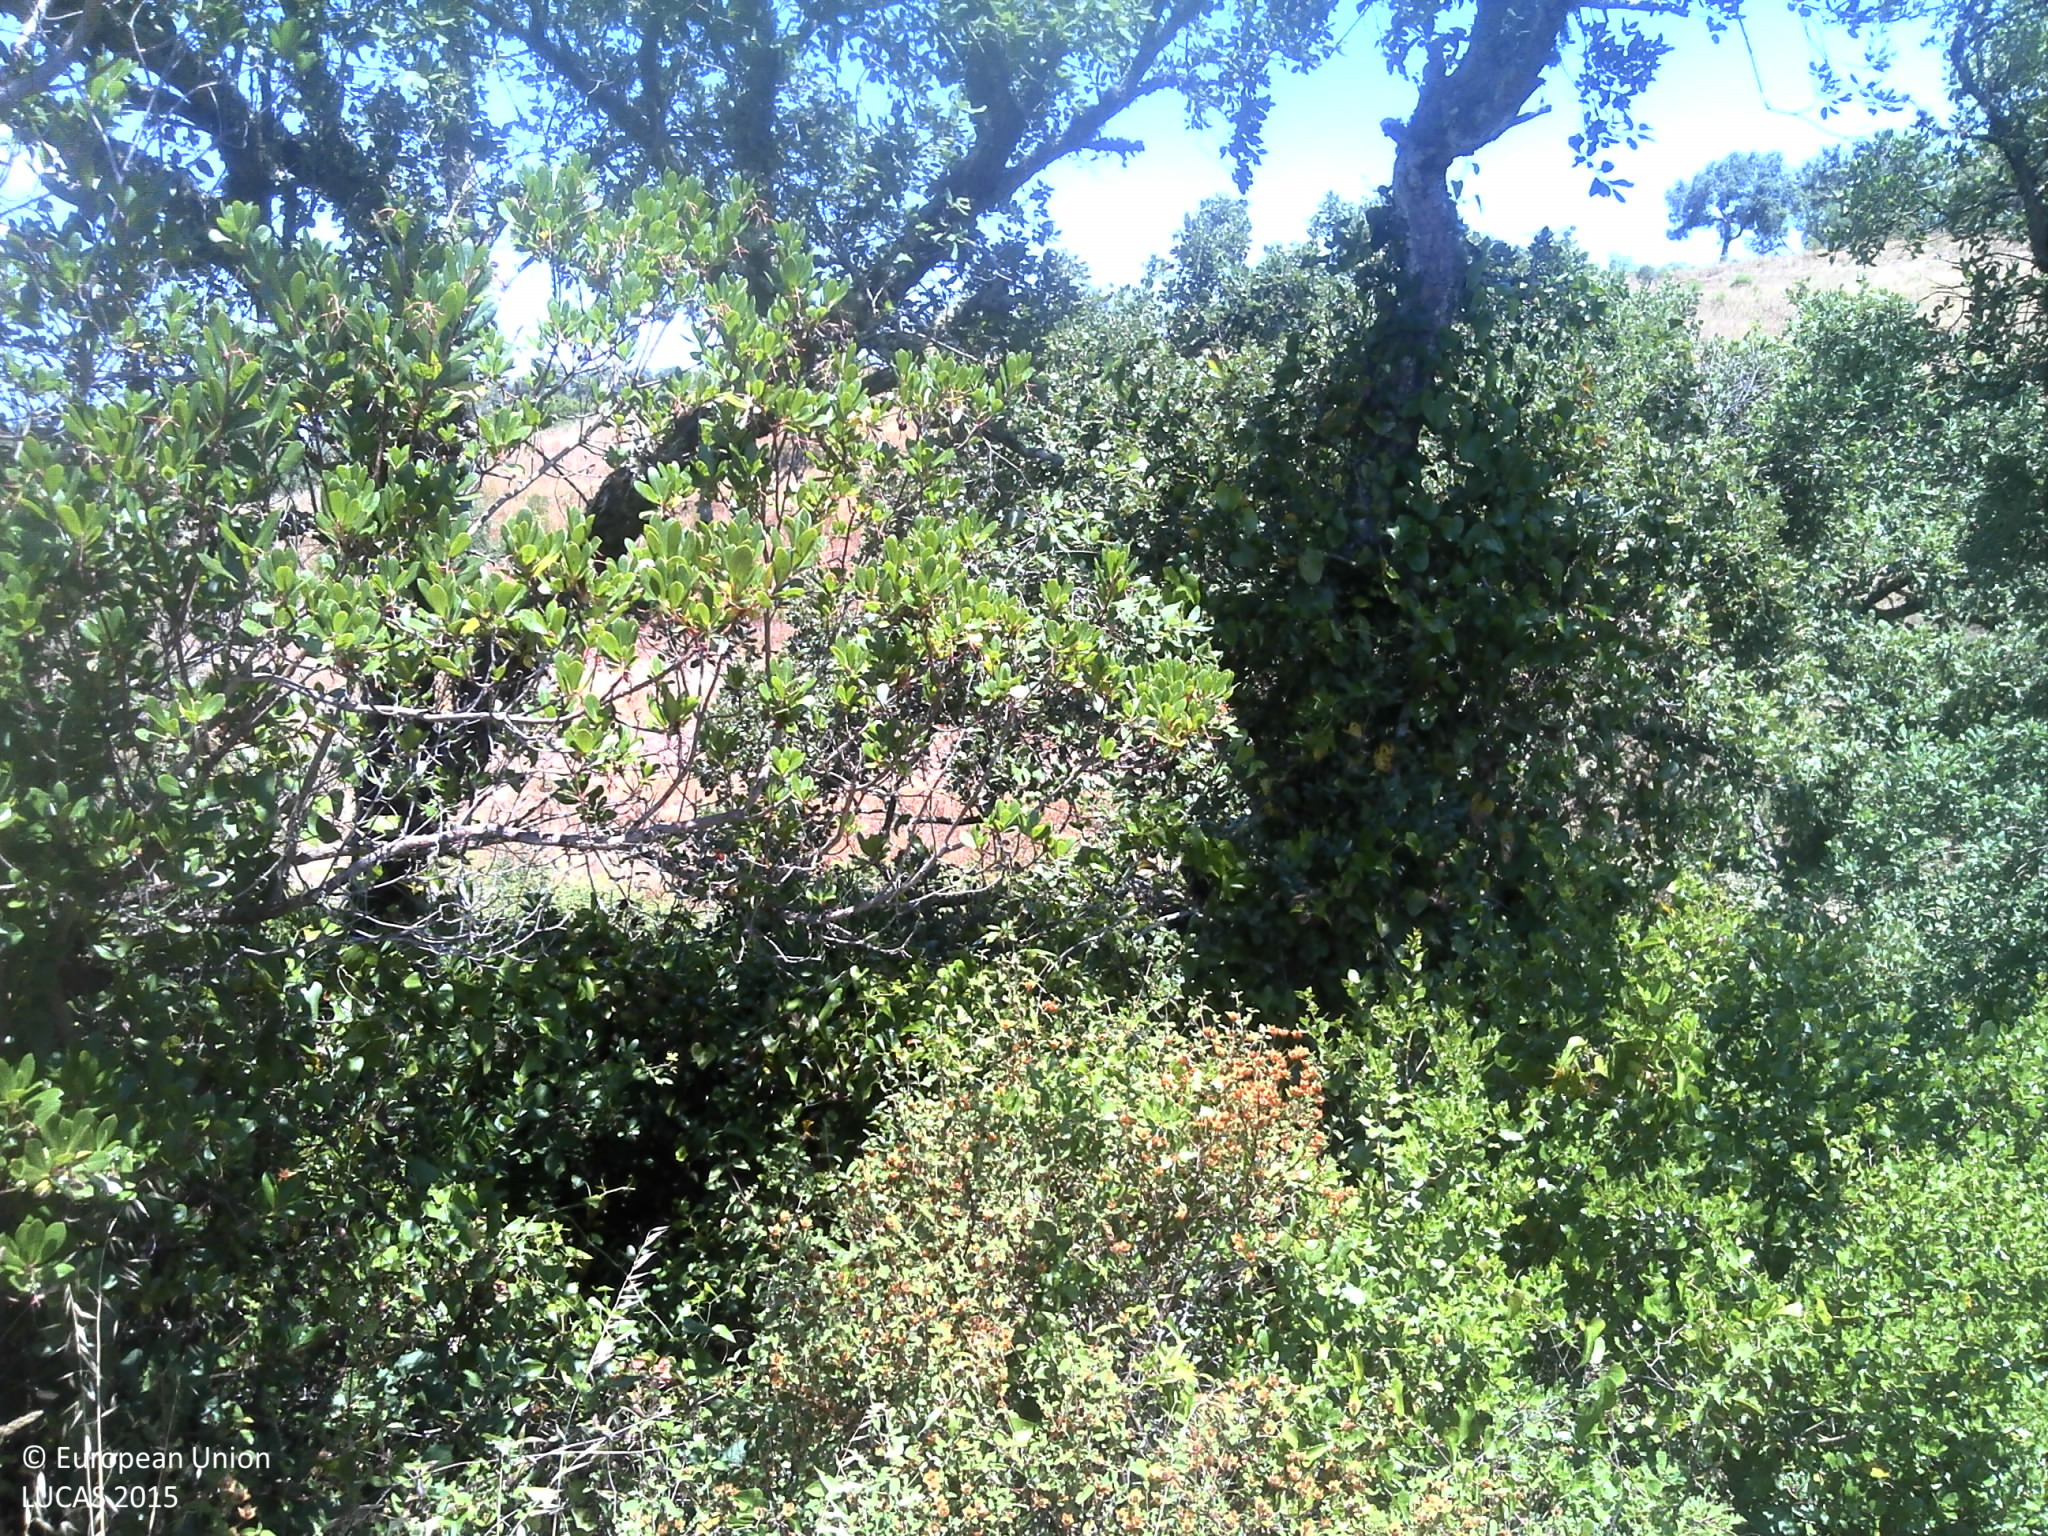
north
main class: Woodland
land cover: Broadleaved woodland
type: broadleaved evergreen forest
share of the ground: 25 - 50 %
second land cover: Shrubland without tree cover
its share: 25 - 50 %
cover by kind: broadleaved forest trees 30 %, herbaceous plants 30 %, shrubs 20 %, unconsolidated bare surface 20 %
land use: Forestry
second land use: Agriculture (excluding fallow land and kitchen gardens)
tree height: > 5 m
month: June
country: PT
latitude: 37.9599
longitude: -8.5619
